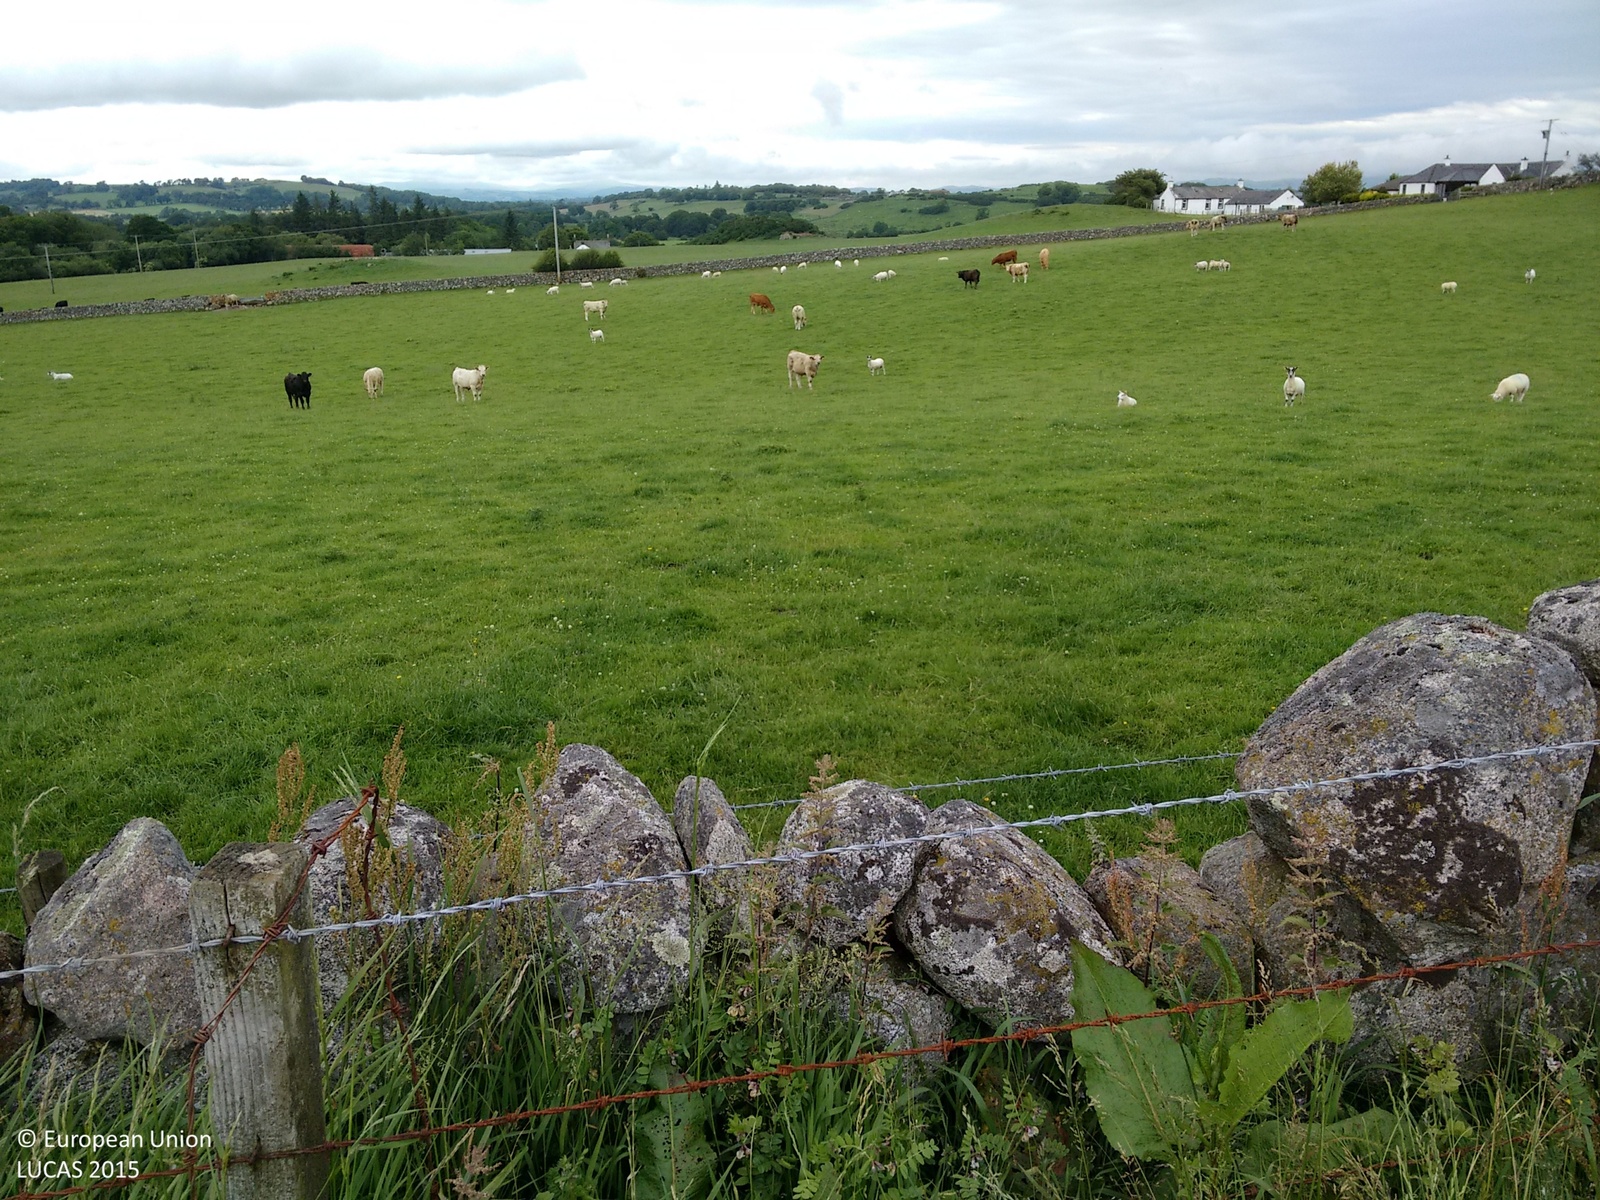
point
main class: Grassland
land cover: Grassland without tree/shrub cover
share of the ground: > 75 %
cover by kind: herbaceous plants 100 %
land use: Agriculture (excluding fallow land and kitchen gardens)
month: July
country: GB
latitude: 54.9667
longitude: -3.5939
